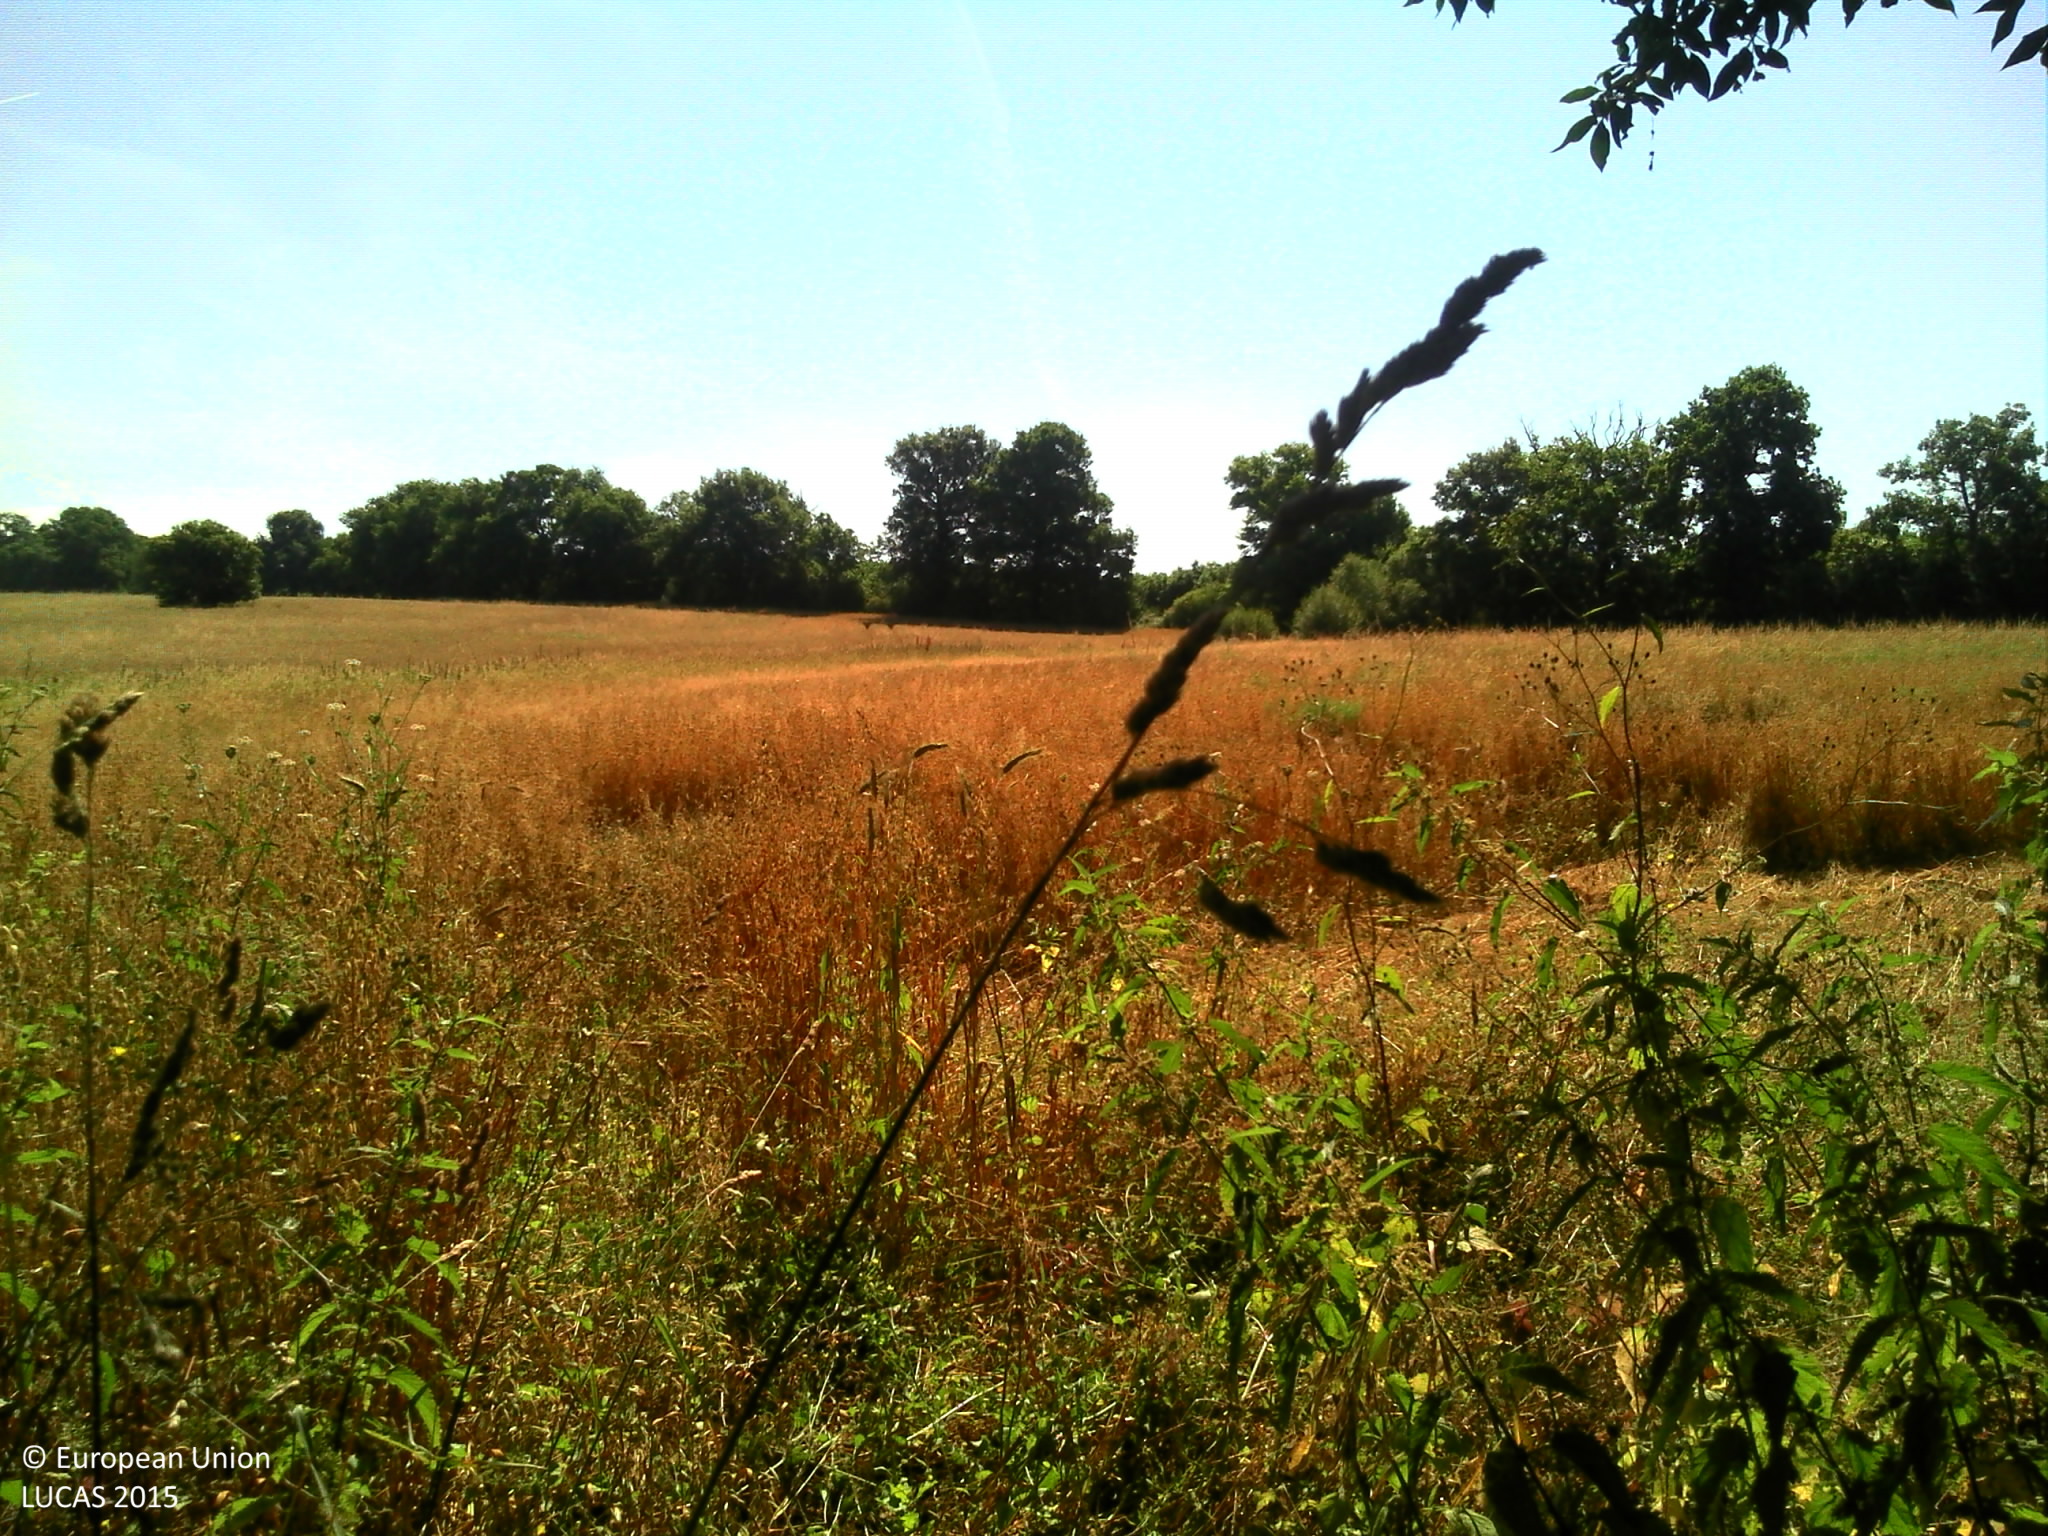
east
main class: Cropland
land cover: Oats
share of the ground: > 75 %
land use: Agriculture (excluding fallow land and kitchen gardens)
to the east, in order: Oats; Fences; Lines of trees
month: June
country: FR
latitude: 46.3435
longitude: 0.9042
